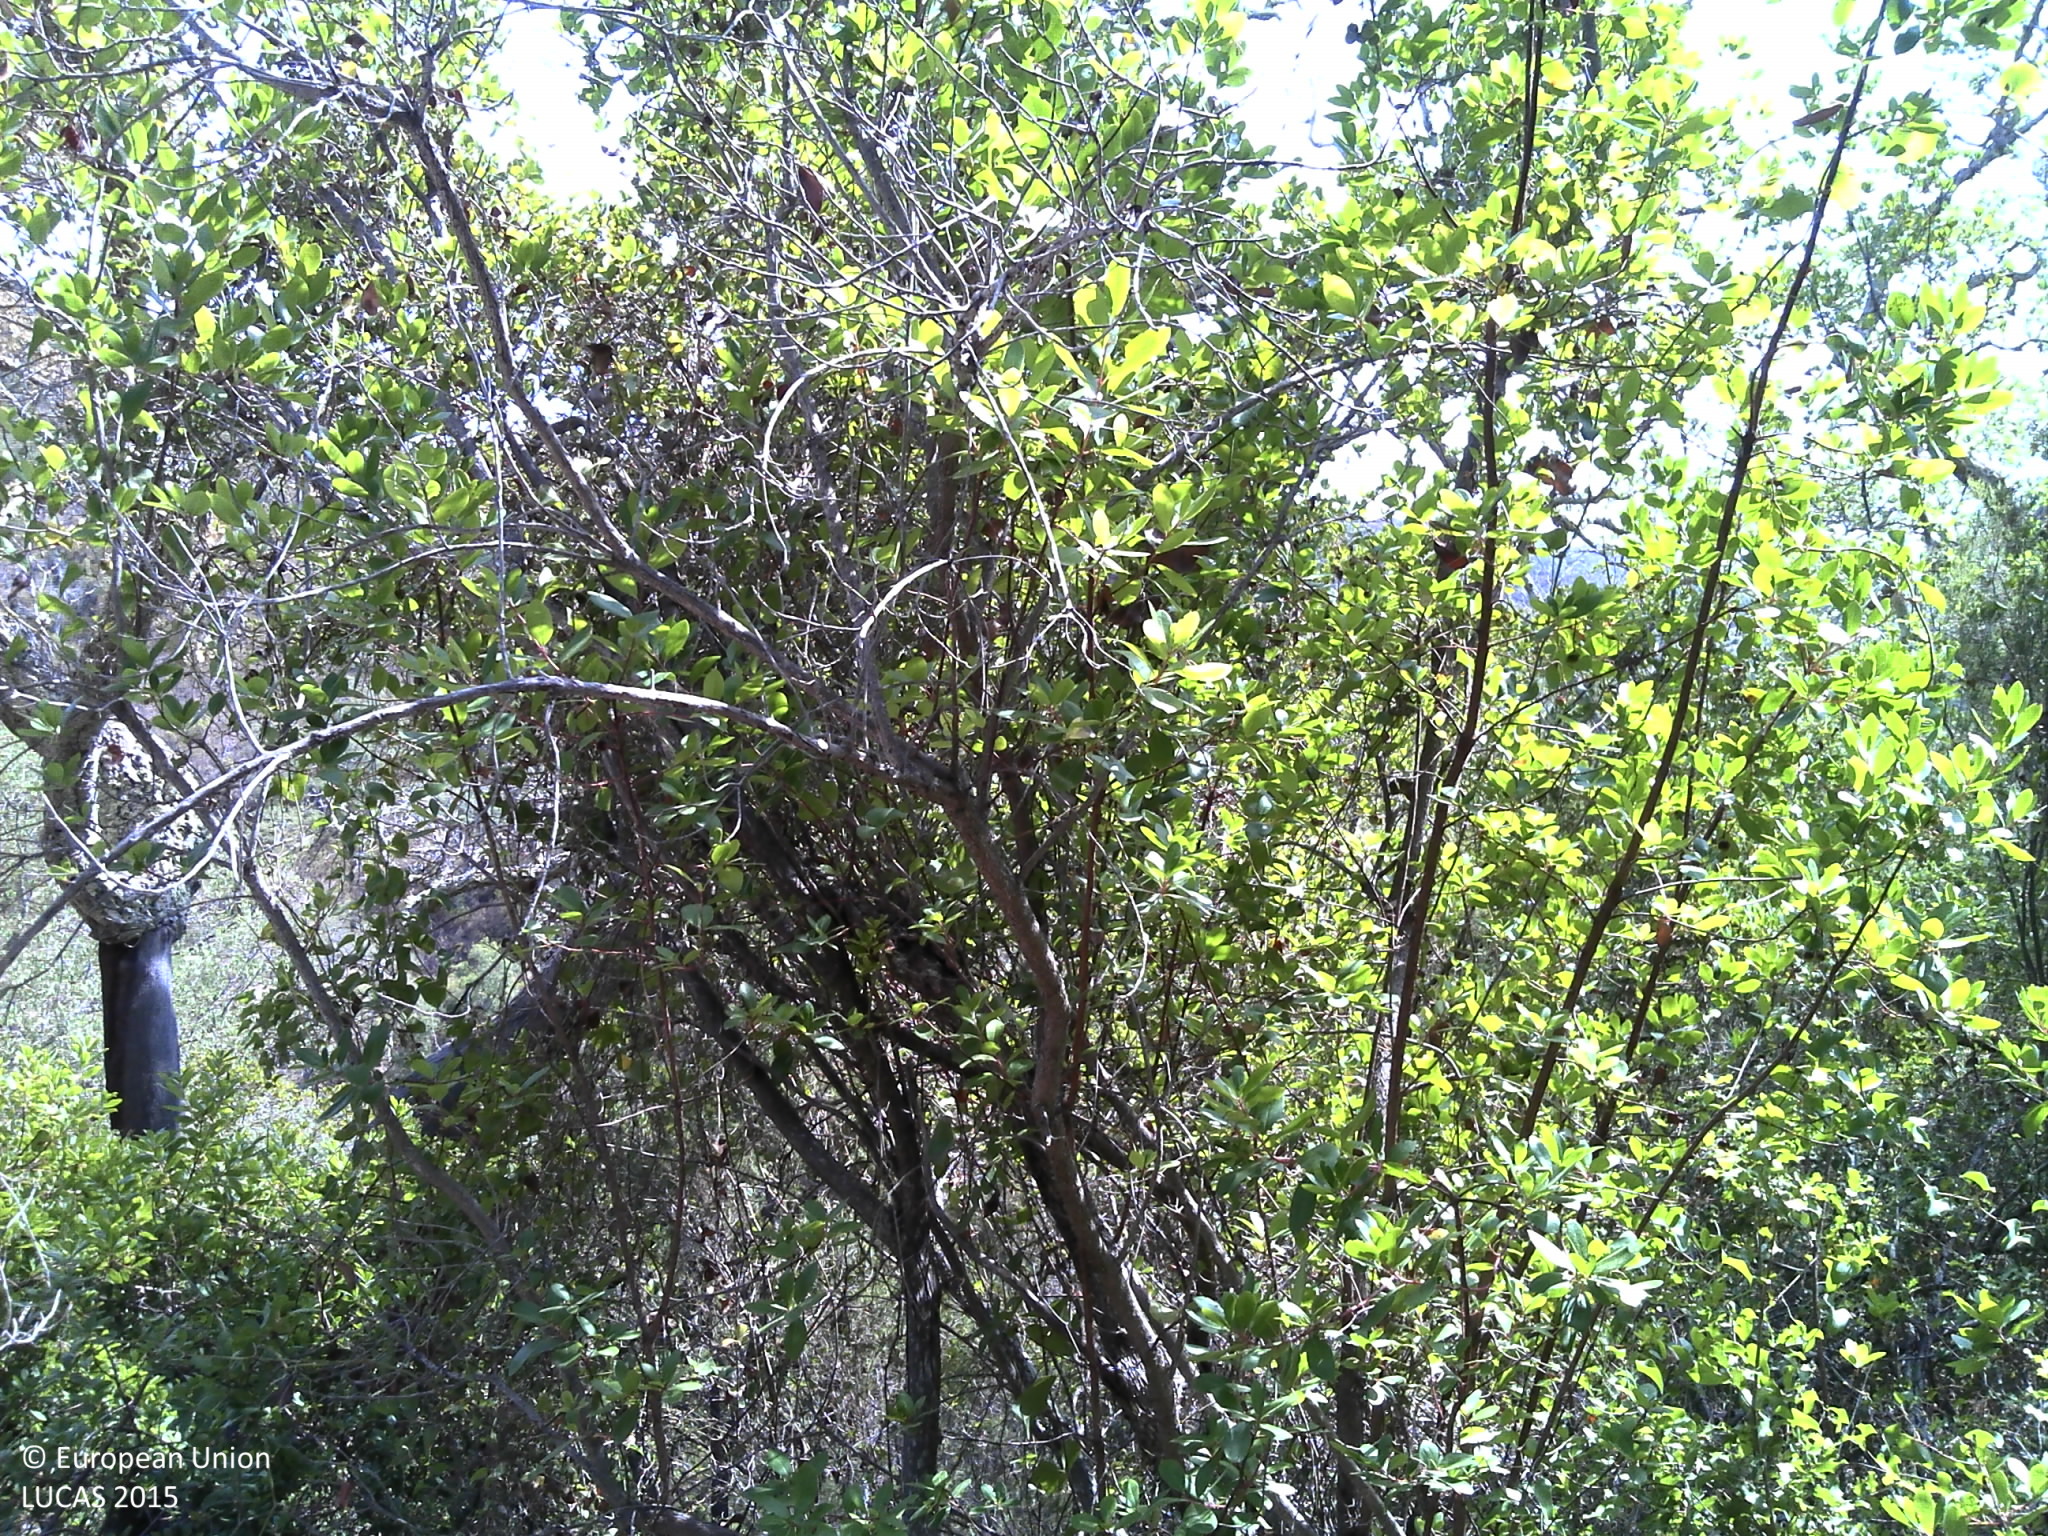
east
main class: Woodland
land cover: Broadleaved woodland
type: broadleaved evergreen forest
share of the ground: 25 - 50 %
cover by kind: shrubs 50 %, broadleaved forest trees 30 %, unconsolidated bare surface 20 %
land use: Forestry
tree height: > 5 m
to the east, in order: Broadleaved woodland; Electric lines; Broadleaved woodland; Shrubland with sparse tree cover; Tracks; Shrubland with sparse tree cover; Rivers and streams; Shrubland with sparse tree cover; Broadleaved woodland
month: September
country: PT
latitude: 37.3930
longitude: -8.2434
